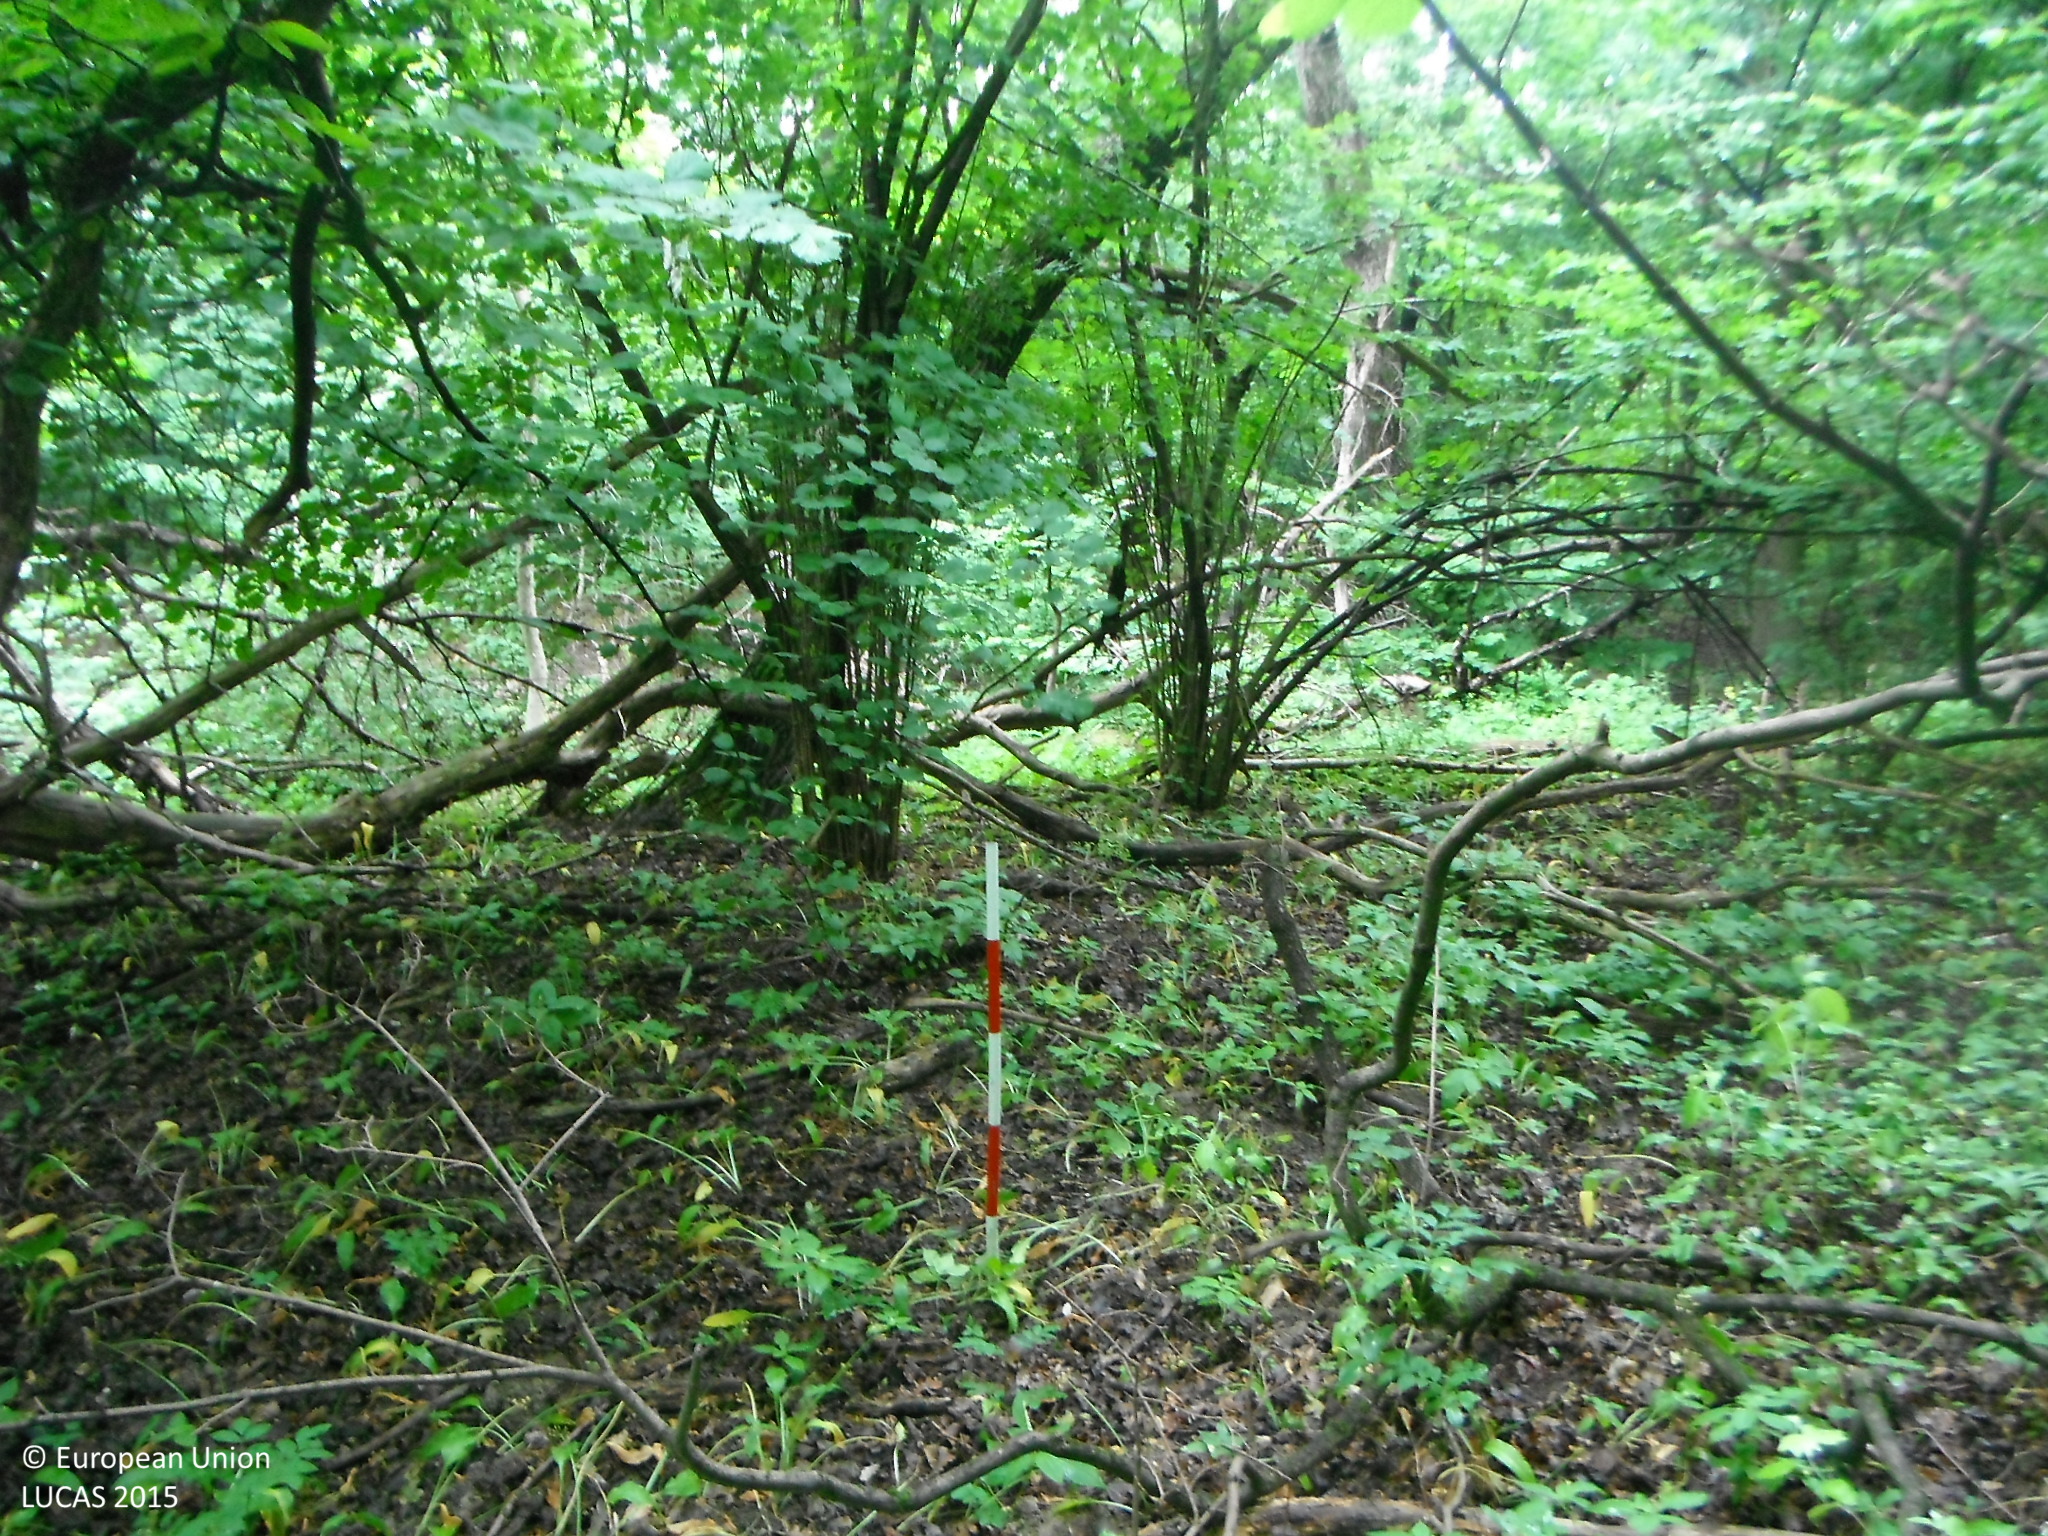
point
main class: Woodland
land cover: Broadleaved woodland
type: floodplain forest
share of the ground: > 75 %
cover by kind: broadleaved forest trees 90 %, herbaceous plants 10 %
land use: Forestry
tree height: > 5 m
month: June
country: SK
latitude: 48.0808
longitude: 17.1627
